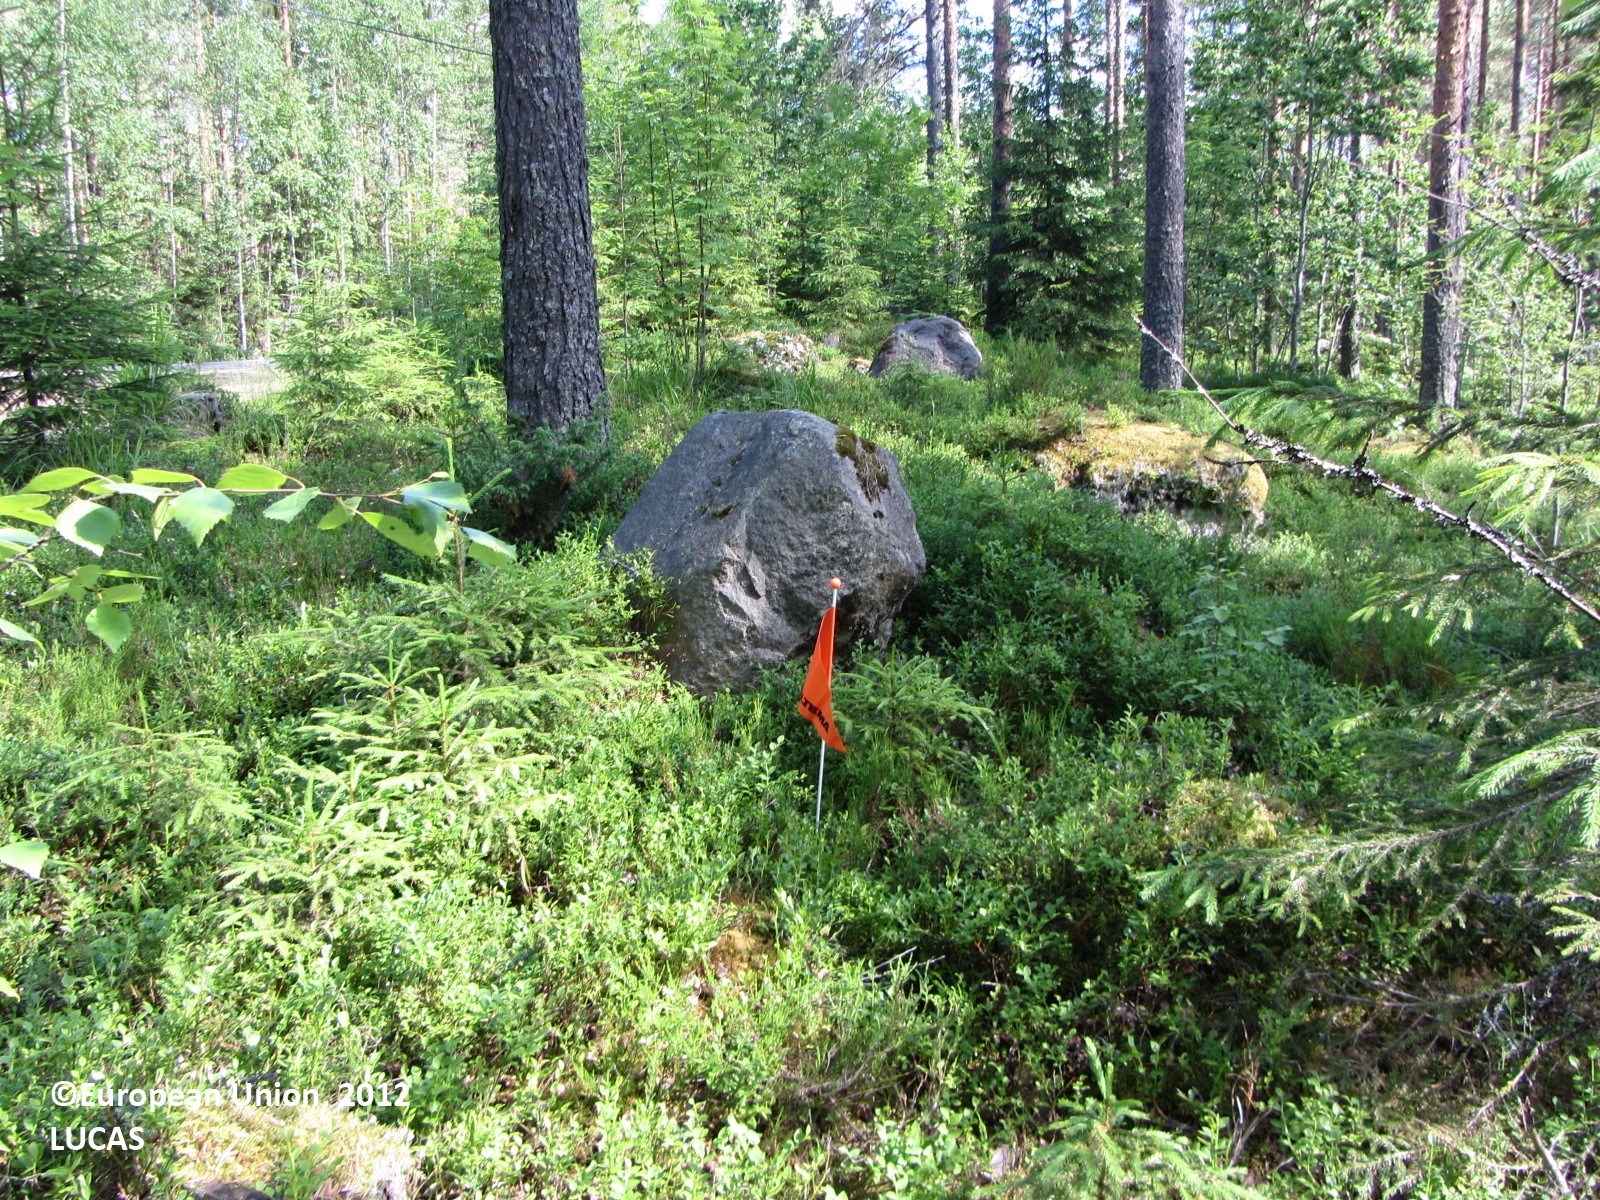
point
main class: Woodland
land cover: Other coniferous woodland
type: boreal forest
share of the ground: 50 - 75 %
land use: Forestry
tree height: > 5 m
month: July
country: FI
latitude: 62.9427
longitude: 25.1742
